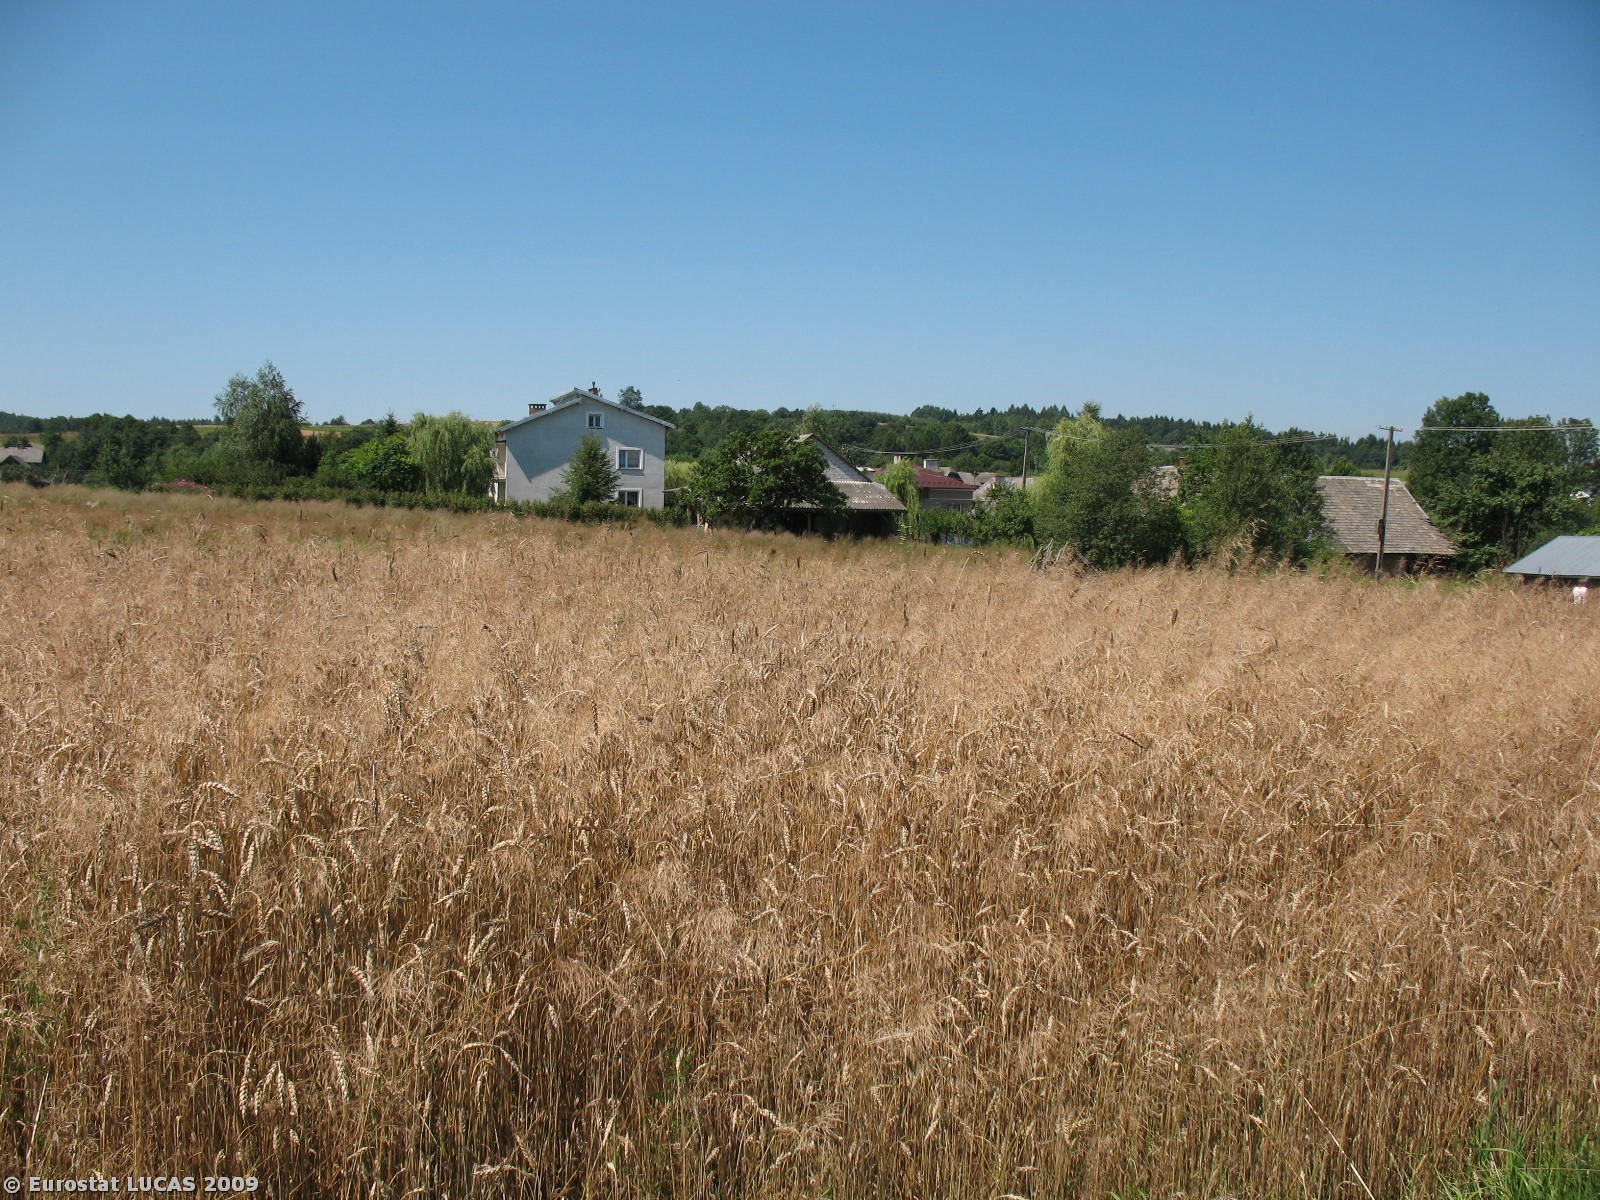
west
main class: Grassland
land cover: Grassland without tree/shrub cover
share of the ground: > 75 %
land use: Agriculture (excluding fallow land and kitchen gardens)
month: July
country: PL
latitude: 49.7146
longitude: 21.9699
